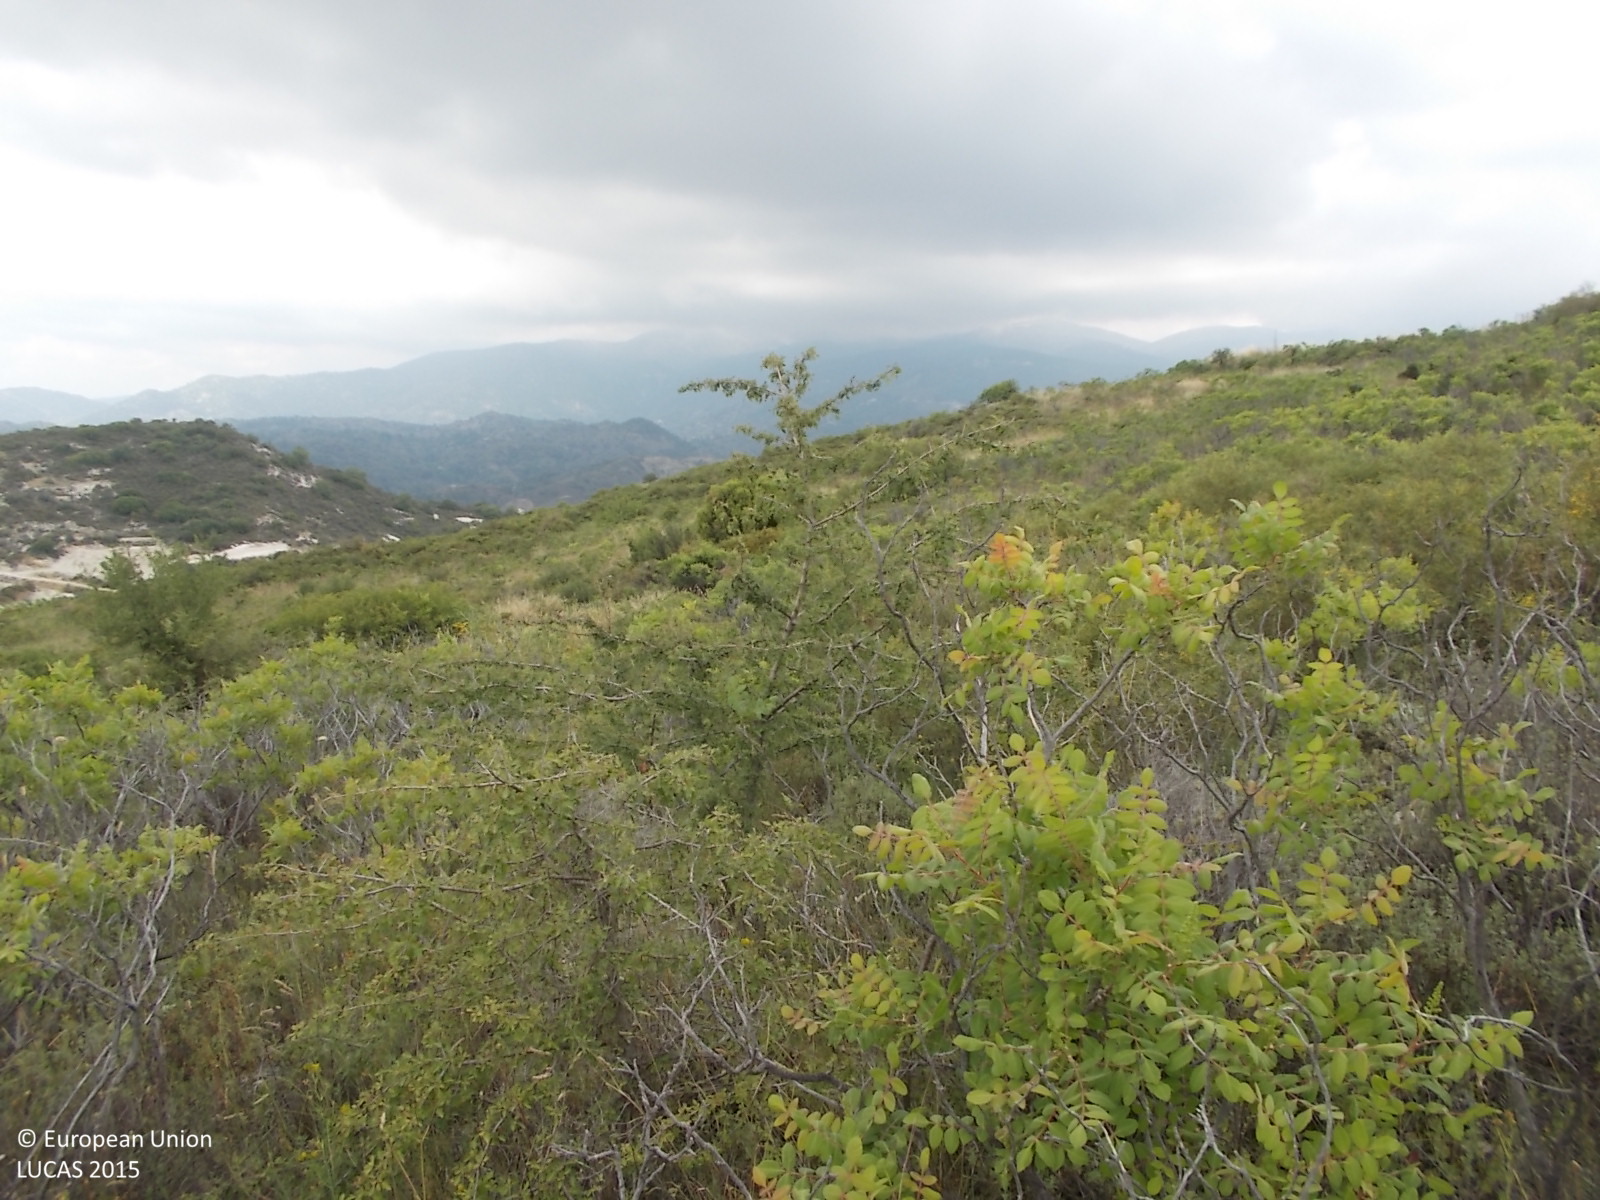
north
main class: Cropland
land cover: Cherry fruit
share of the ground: 50 - 75 %
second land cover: Shrubland without tree cover
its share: 25 - 50 %
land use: Abandoned areas
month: June
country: CY
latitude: 34.8545
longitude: 32.8360
